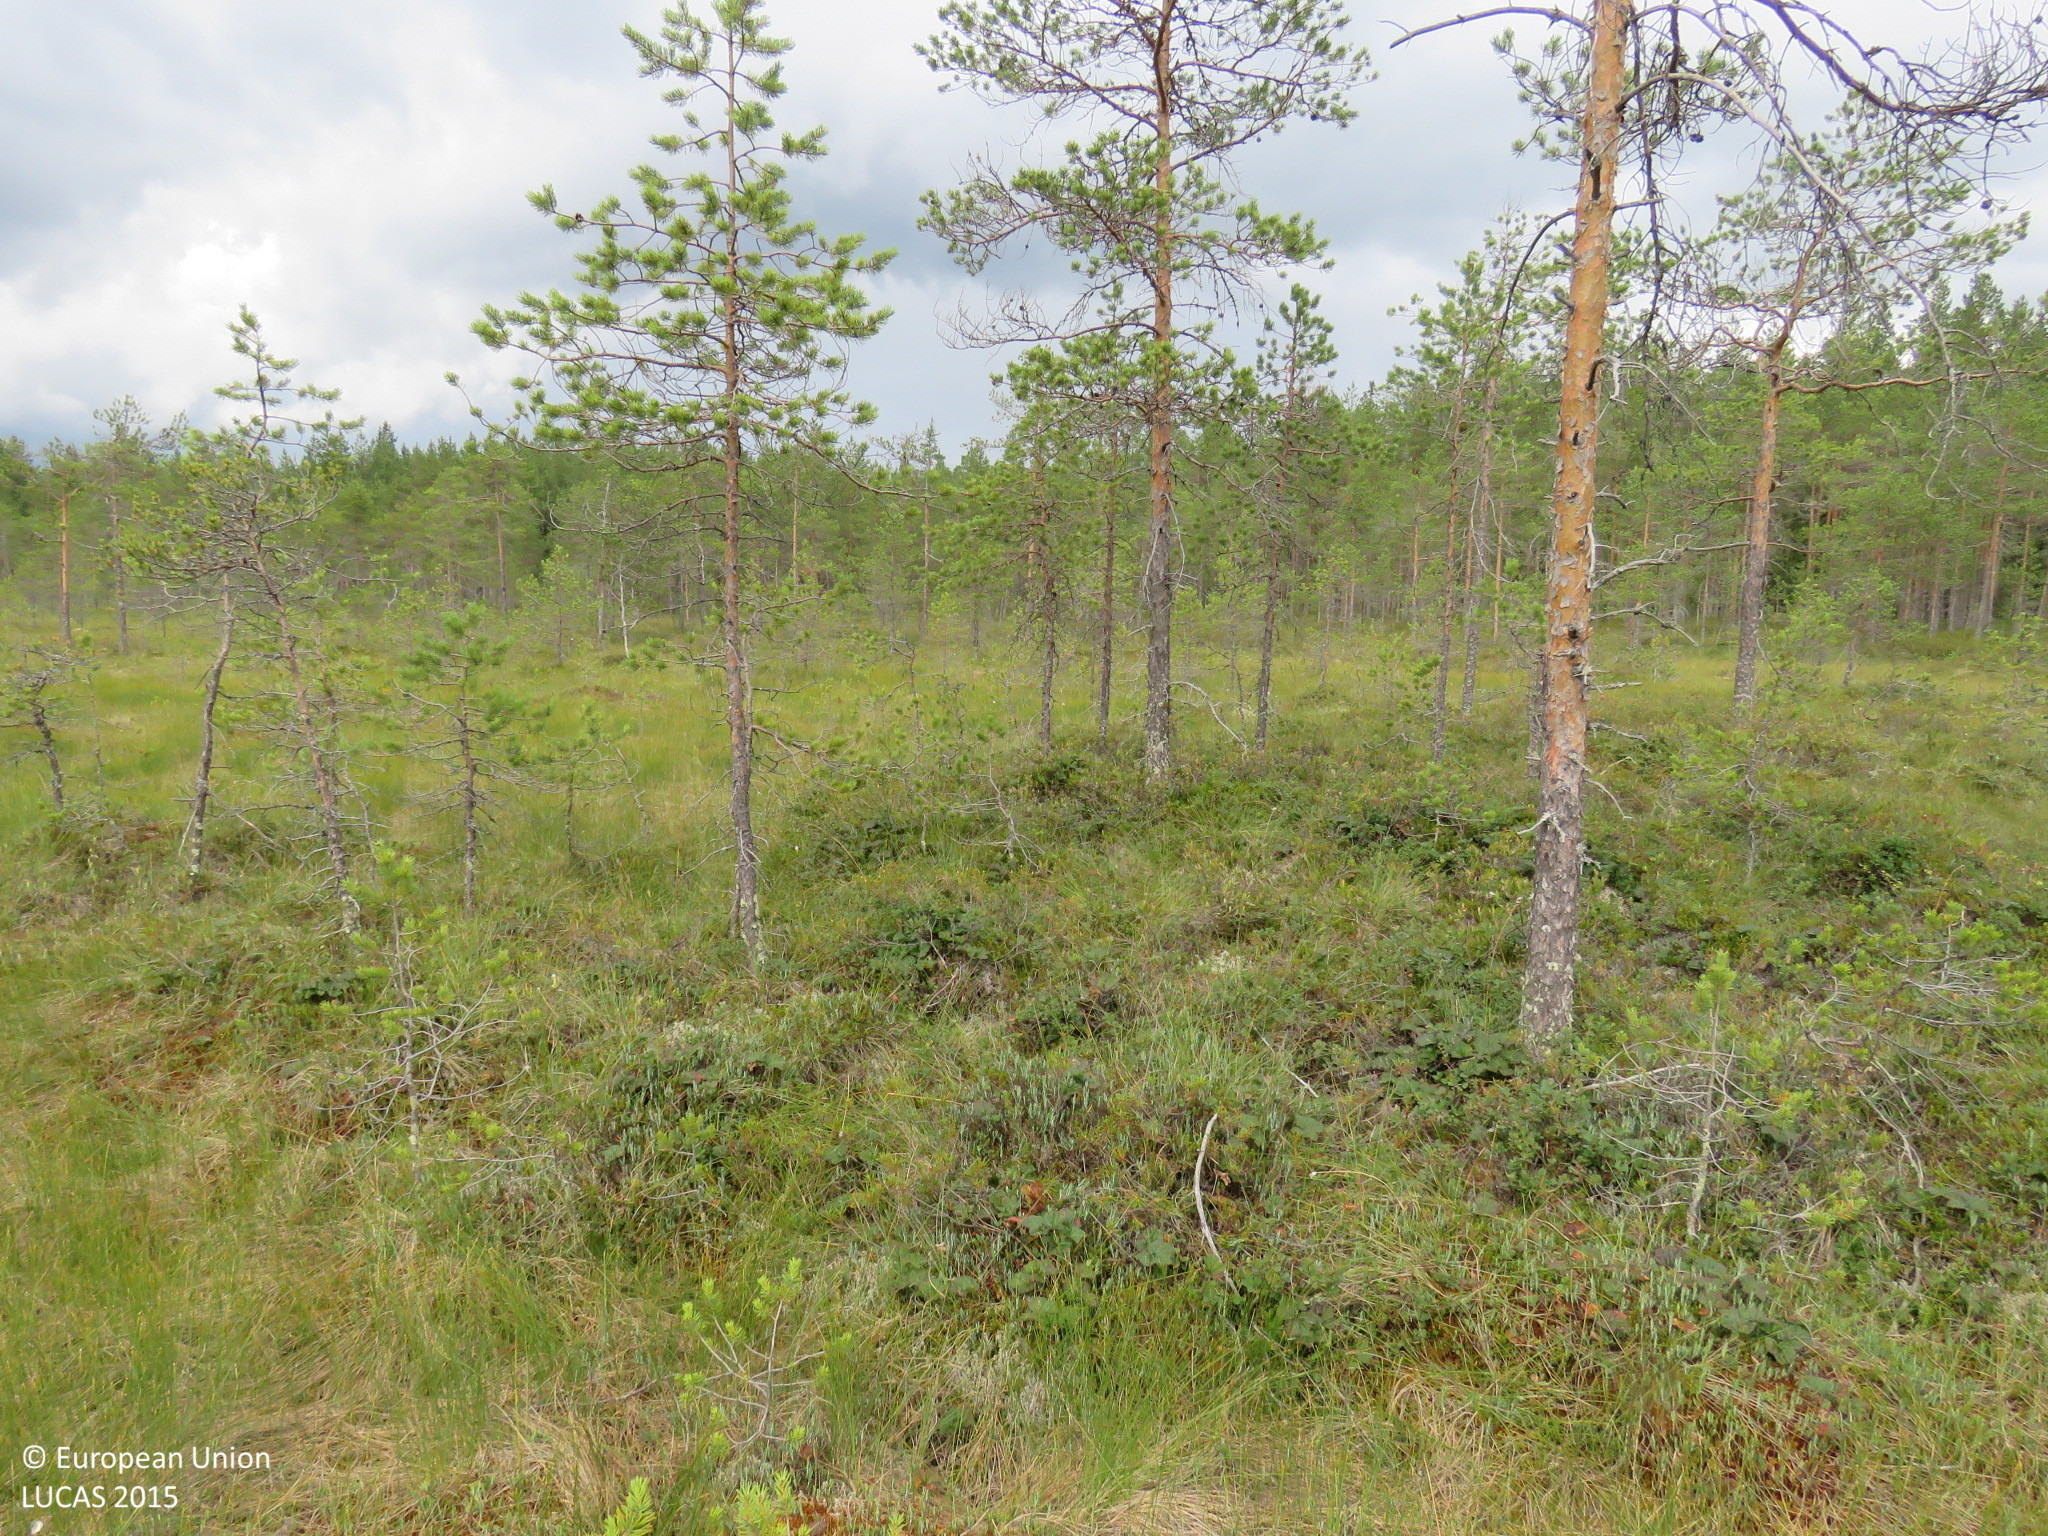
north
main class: Woodland
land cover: Pine dominated coniferous woodland
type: mire and swamp forests
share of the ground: 25 - 50 %
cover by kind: herbaceous plants 65 %, coniferous forest trees 25 %, shrubs 5 %, lichens and mosses 5 %
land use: Semi-natural and natural areas not in use
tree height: < 5 m
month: July
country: FI
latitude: 64.2500
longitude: 26.3074
